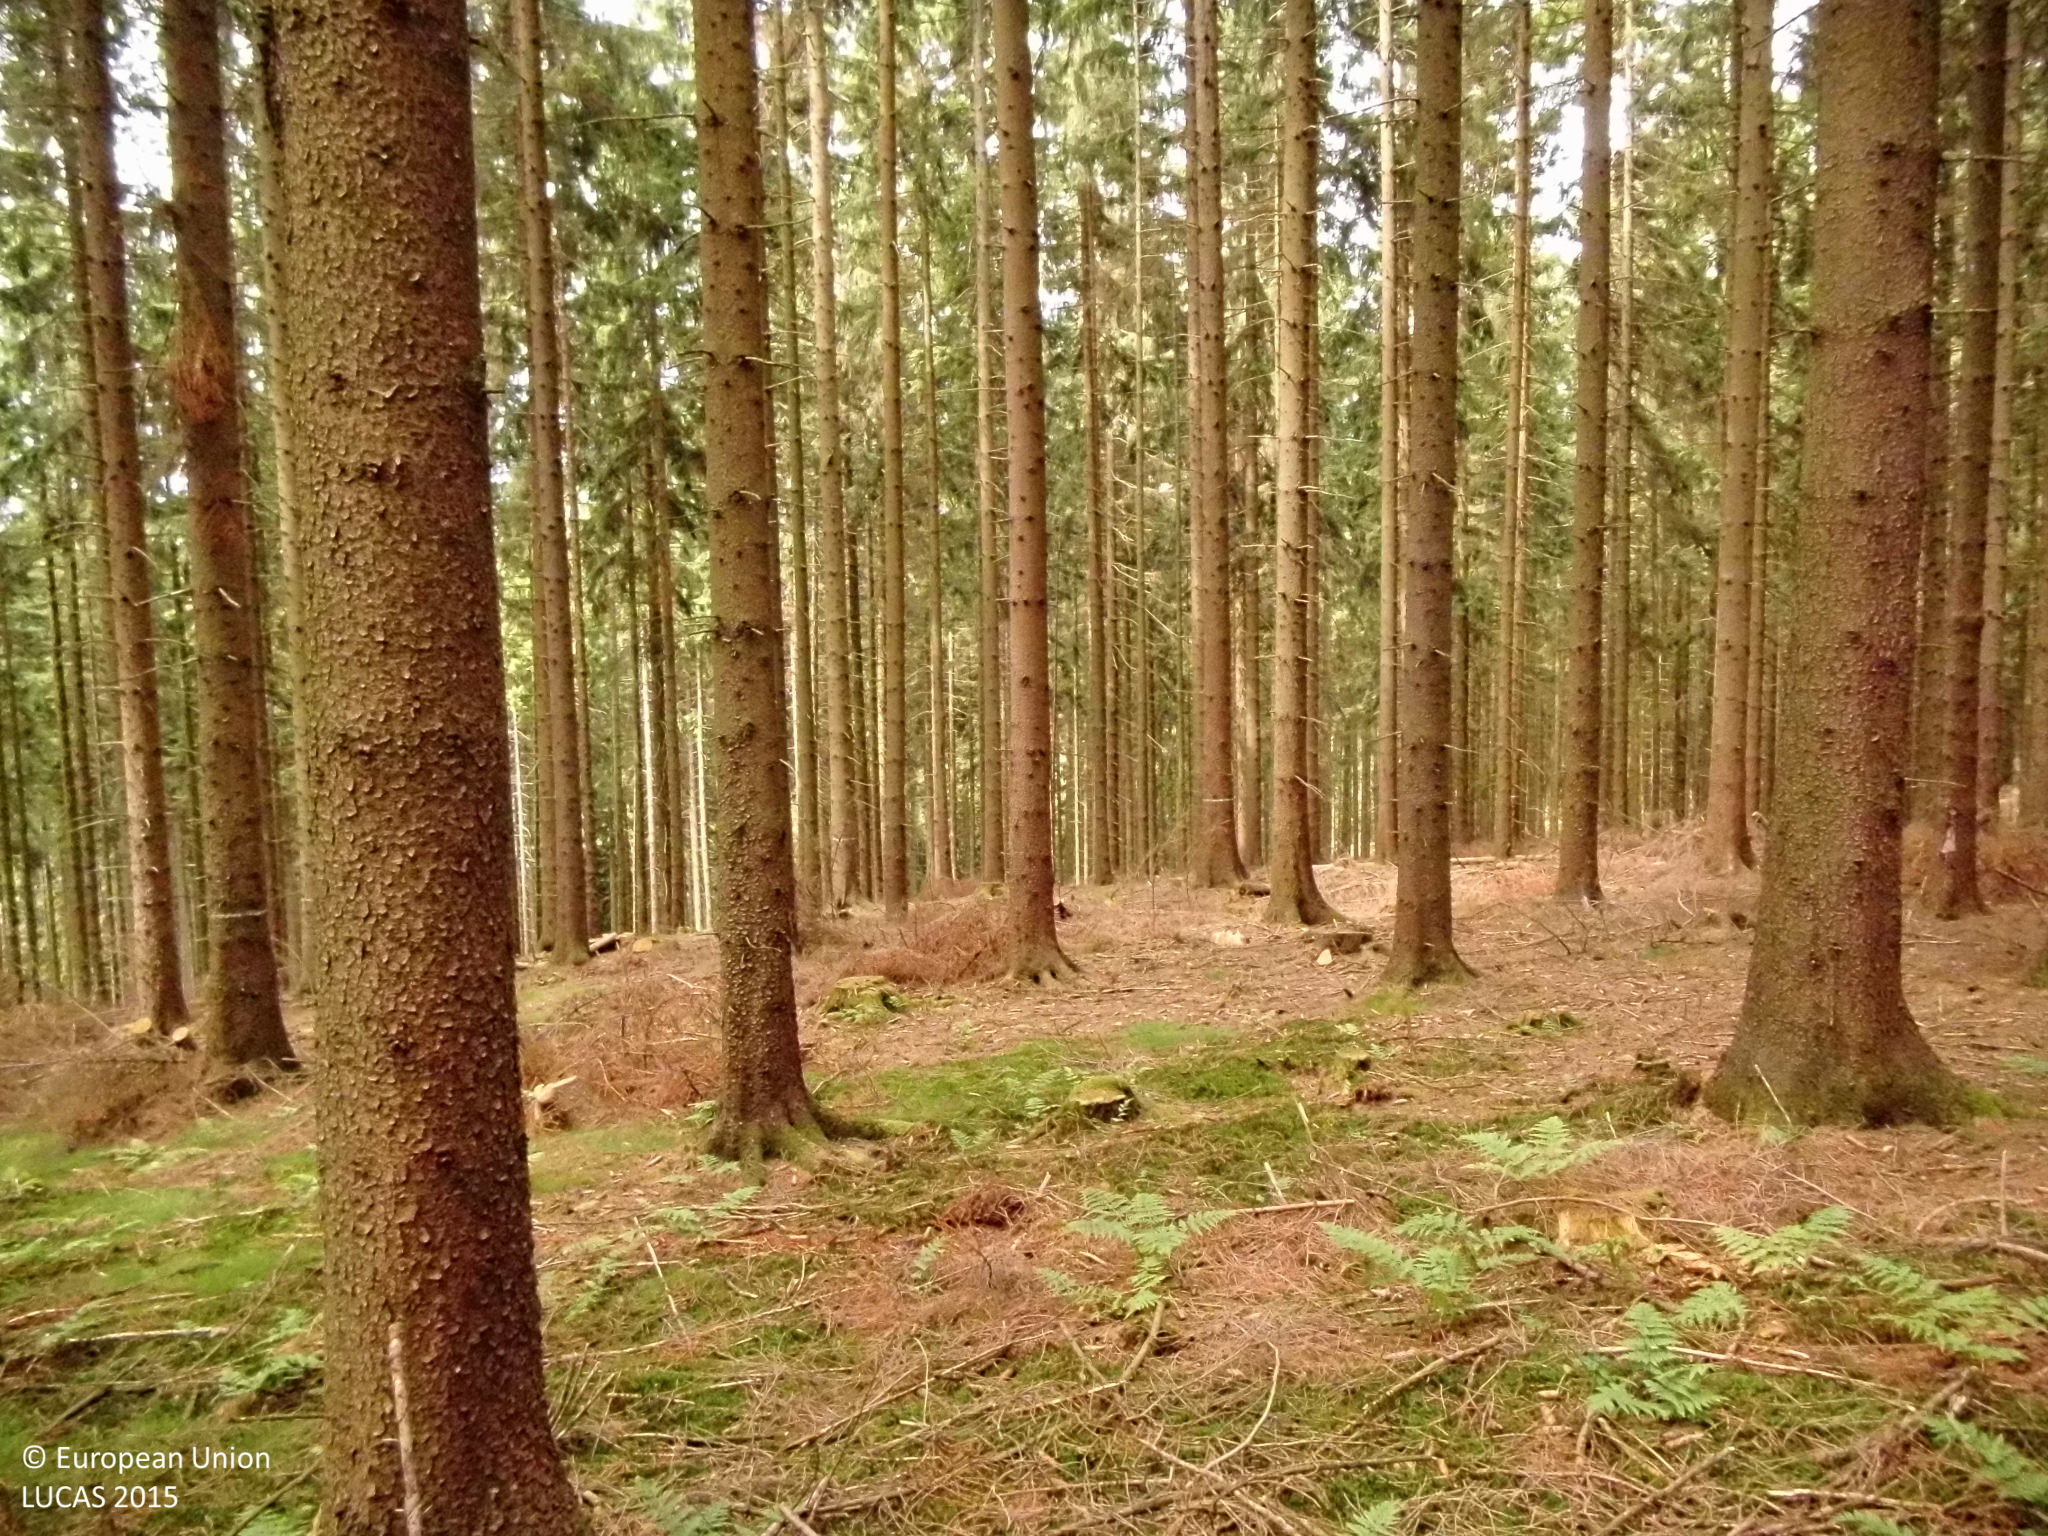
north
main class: Woodland
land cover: Spruce dominated coniferous woodland
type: hemiboreal forest and nemoral coniferous forest and mixed broadleaved-coniferous forest
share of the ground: > 75 %
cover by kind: coniferous forest trees 75 %, herbaceous plants 10 %, unconsolidated bare surface 10 %, lichens and mosses 5 %
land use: Forestry
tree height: > 5 m
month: July
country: DE
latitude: 50.7243
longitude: 8.0030
